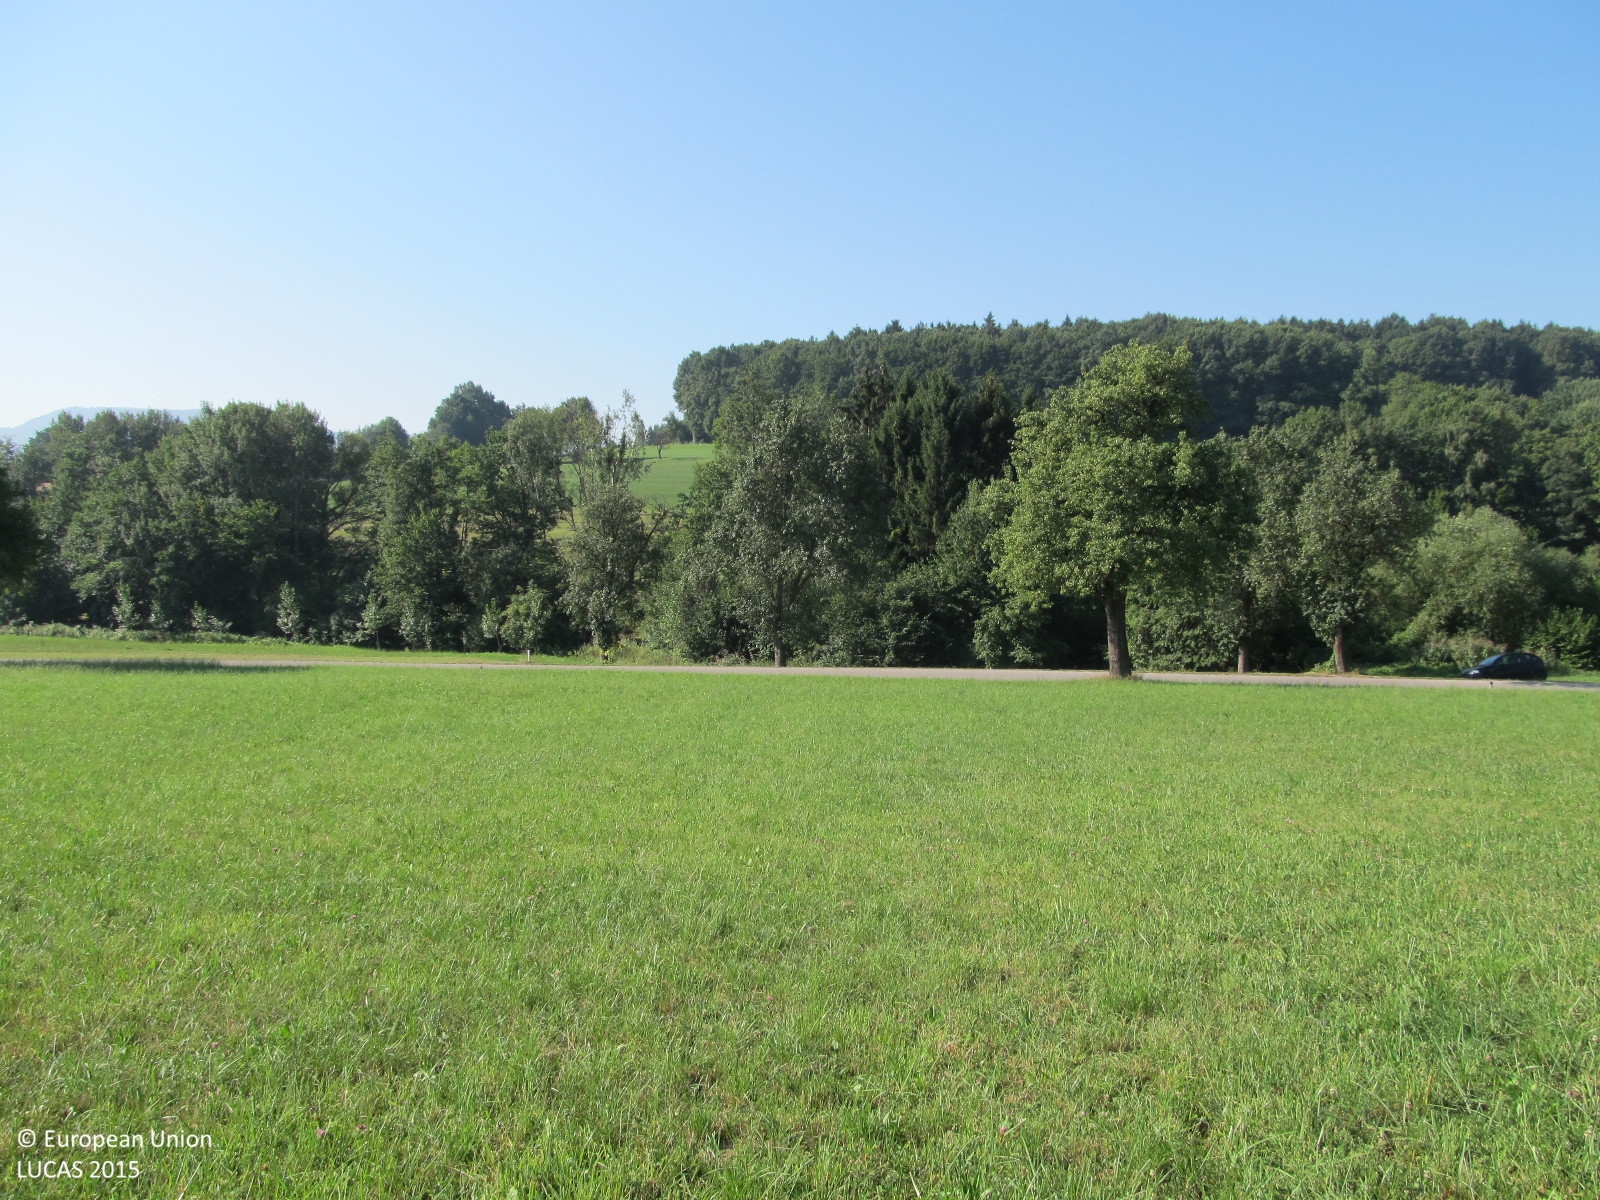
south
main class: Grassland
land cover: Grassland without tree/shrub cover
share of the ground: > 75 %
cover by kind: herbaceous plants 100 %
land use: Agriculture (excluding fallow land and kitchen gardens)
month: August
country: AT
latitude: 48.1171
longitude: 15.6040
